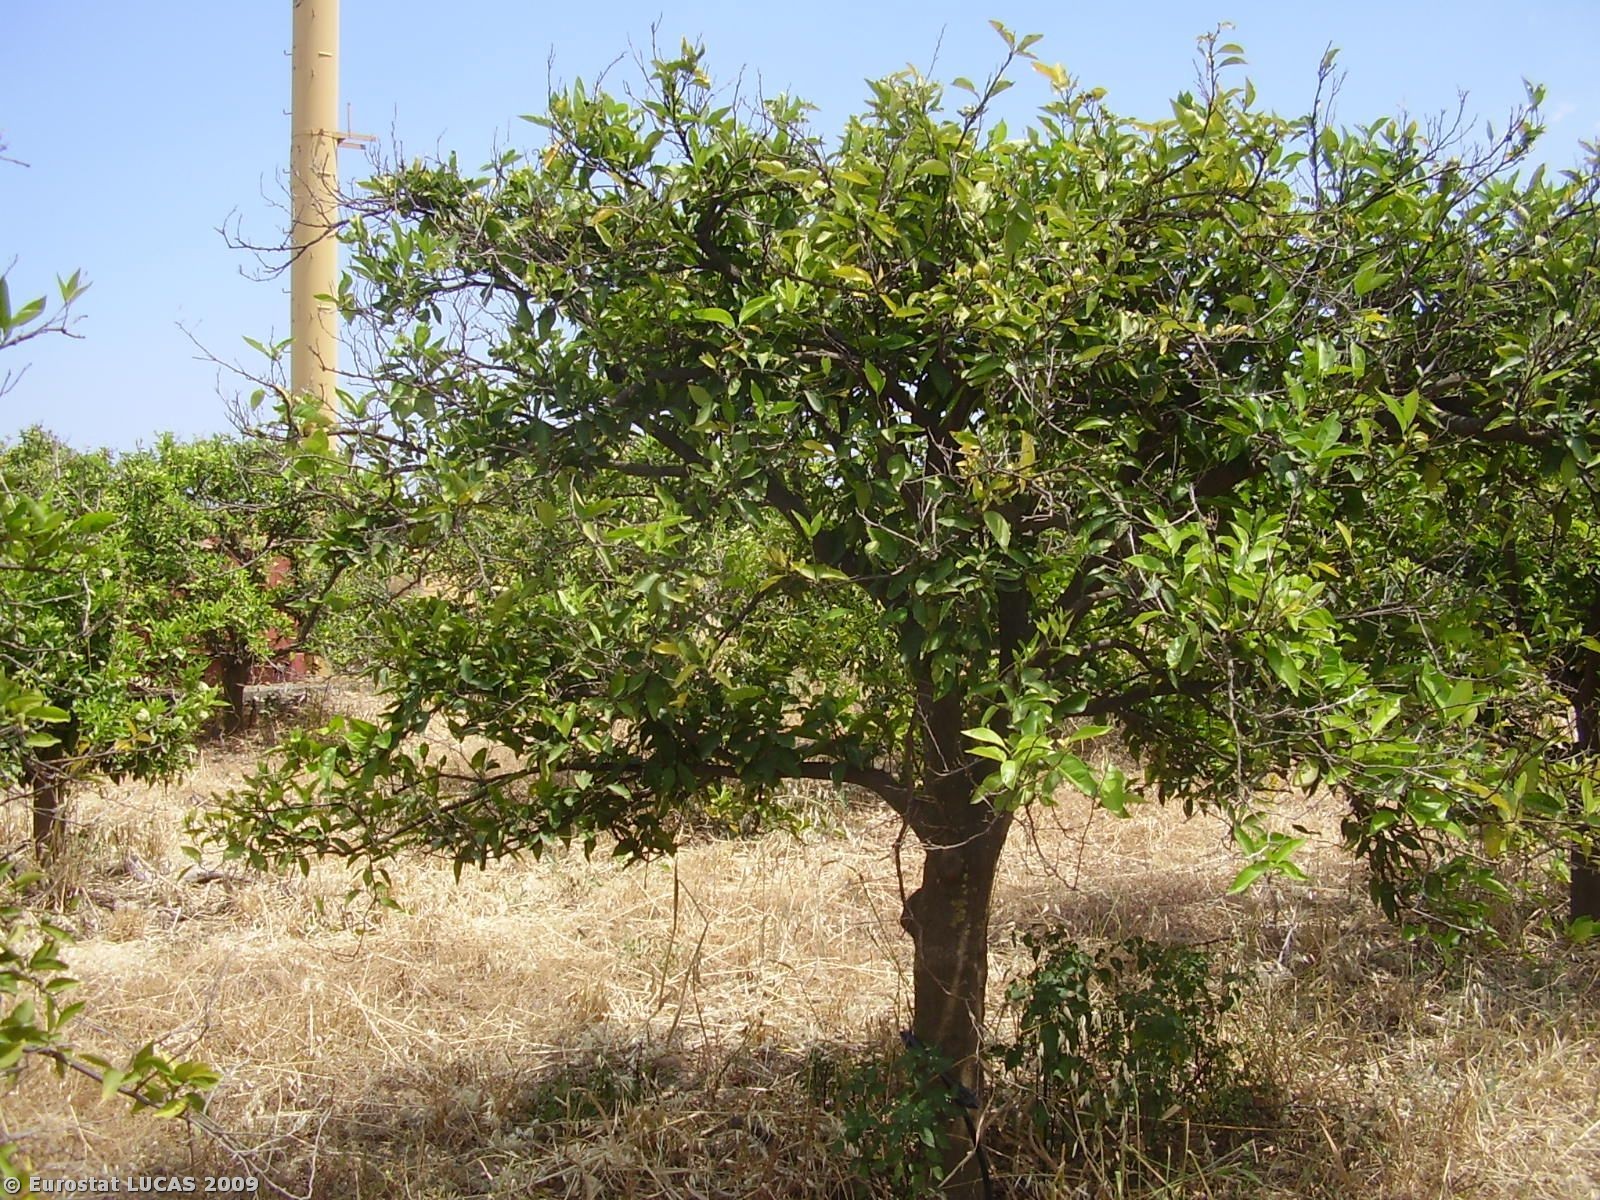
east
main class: Cropland
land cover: Oranges
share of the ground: 25 - 50 %
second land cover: Spontaneously vegetated surfaces
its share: > 75 %
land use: Agriculture (excluding fallow land and kitchen gardens)
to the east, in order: Oranges; Bare land; Olive groves; Bare land; Tracks; Oranges; Bare land
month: June
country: IT
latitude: 37.4754
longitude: 14.9059
